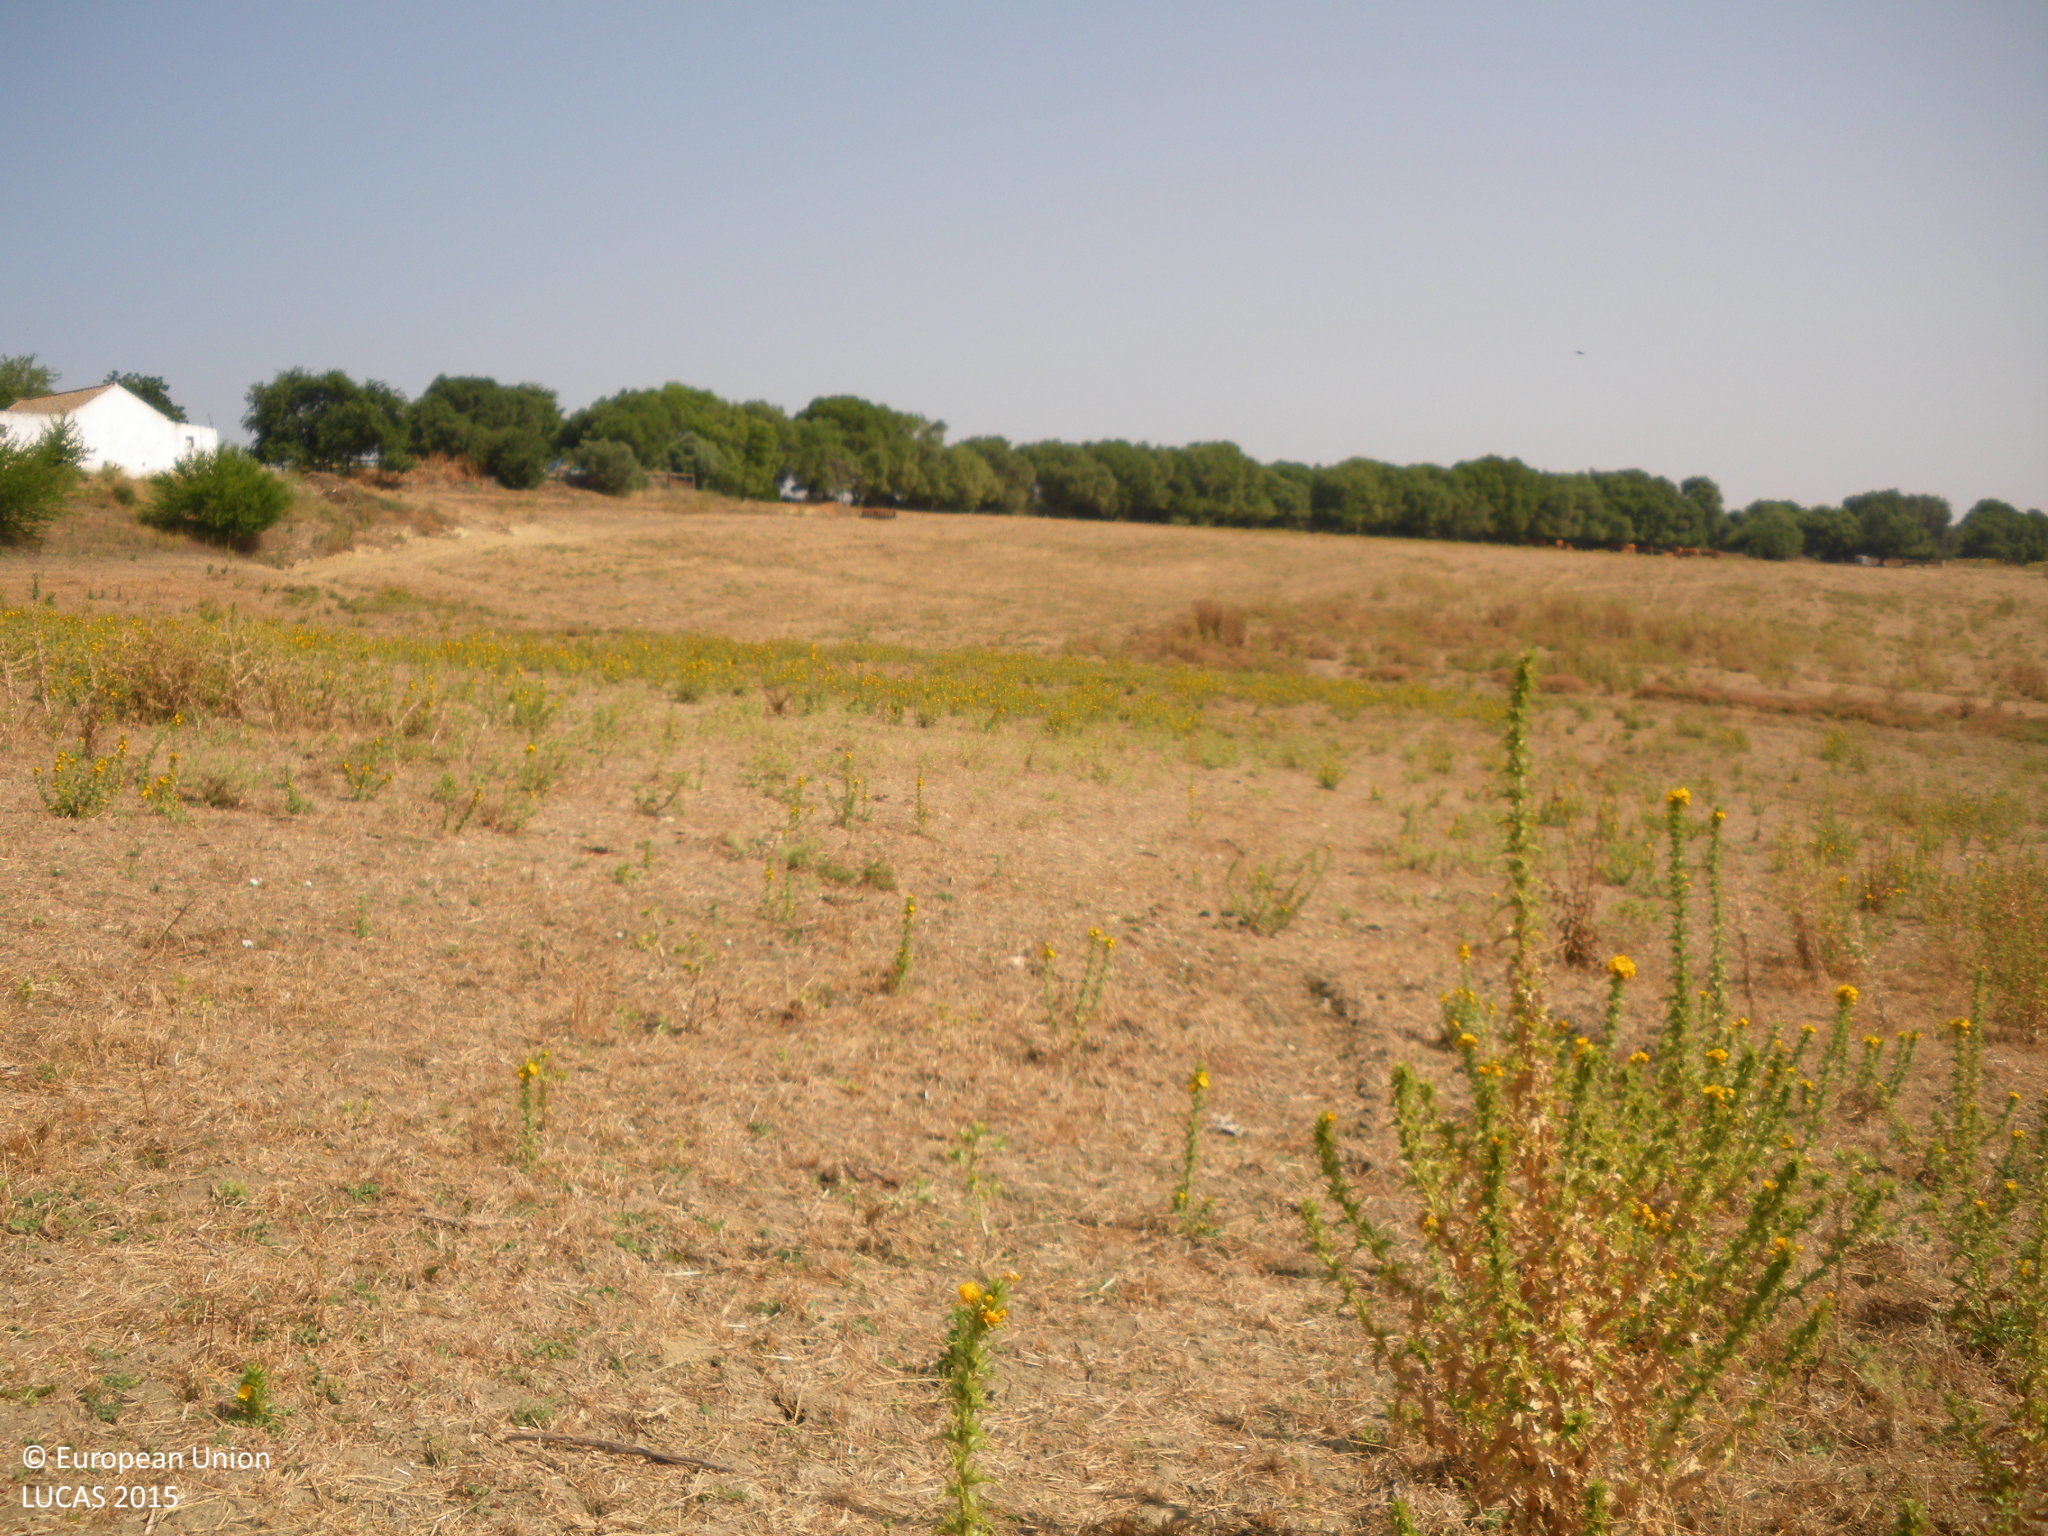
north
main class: Grassland
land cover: Spontaneously vegetated surfaces
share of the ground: 25 - 50 %
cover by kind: unconsolidated bare surface 70 %, herbaceous plants 30 %
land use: Agriculture (excluding fallow land and kitchen gardens)
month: July
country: ES
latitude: 36.7483
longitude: -5.6982
